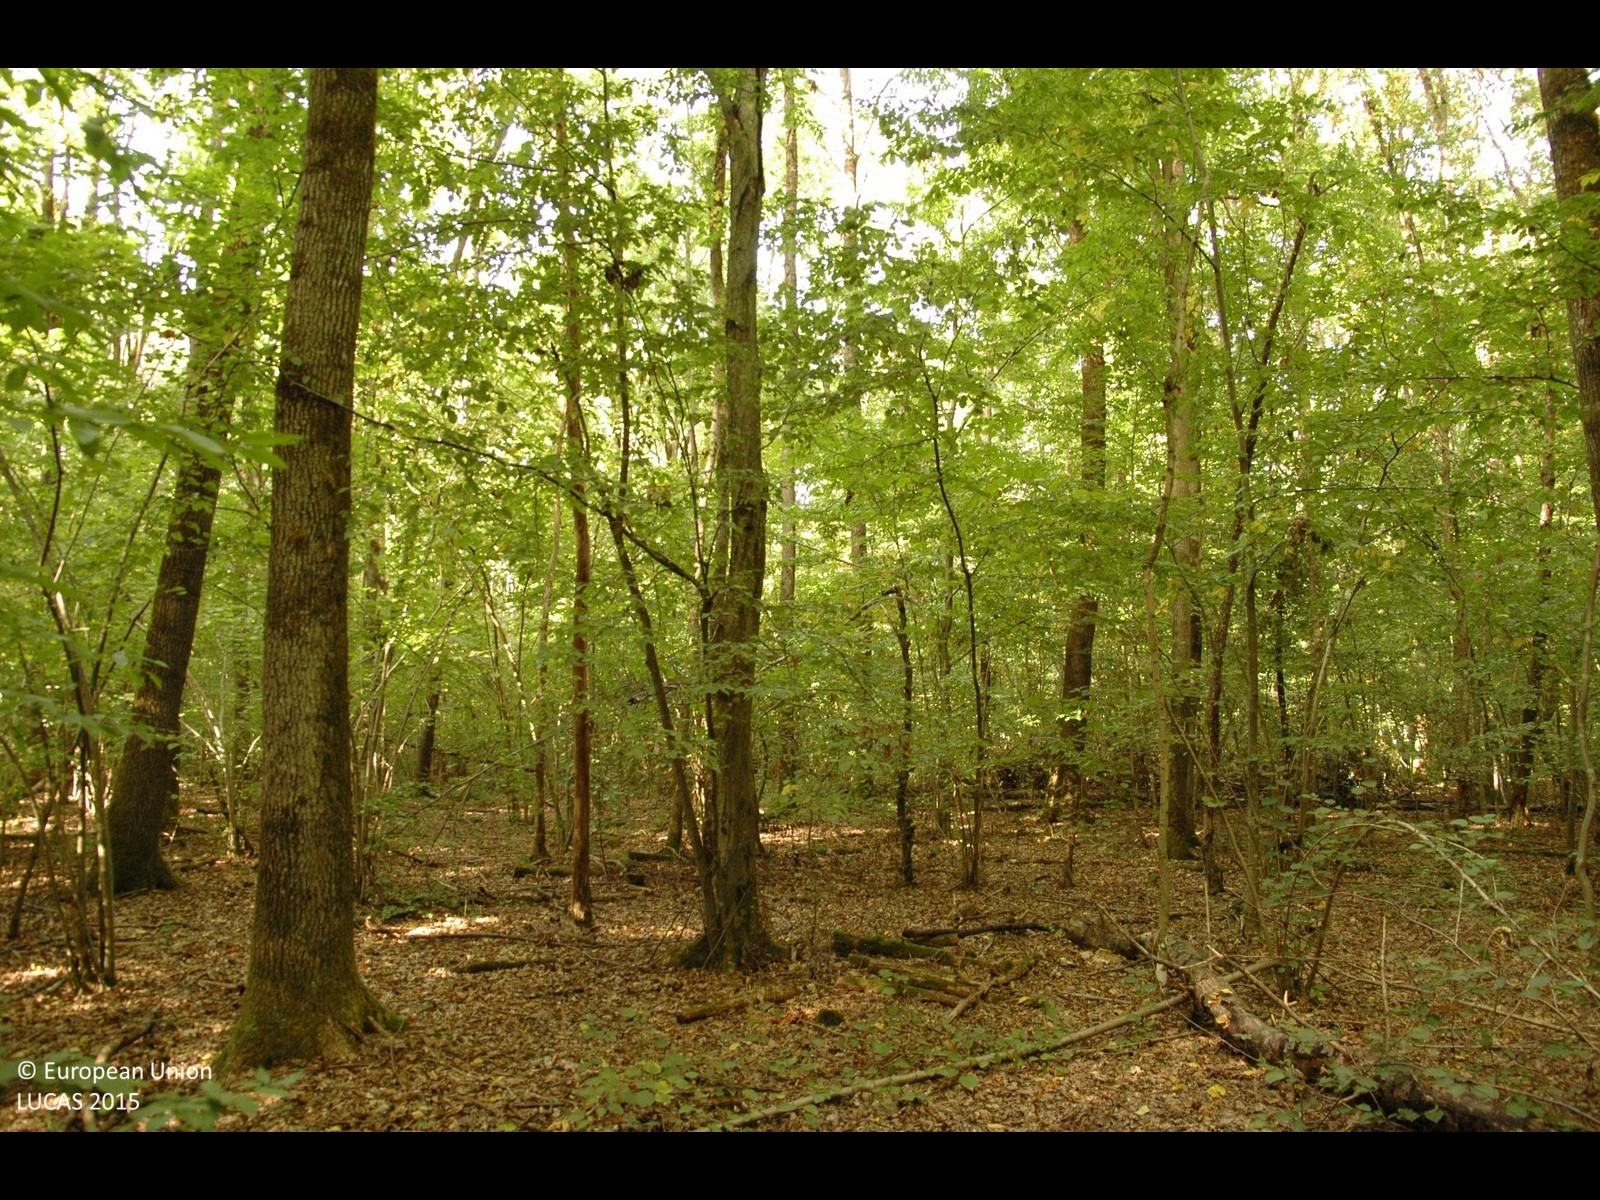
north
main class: Woodland
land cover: Broadleaved woodland
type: mesophytic deciduous forest
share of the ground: > 75 %
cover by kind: broadleaved forest trees 100 %
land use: Forestry
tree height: > 5 m
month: September
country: HR
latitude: 45.6803
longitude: 15.9418
